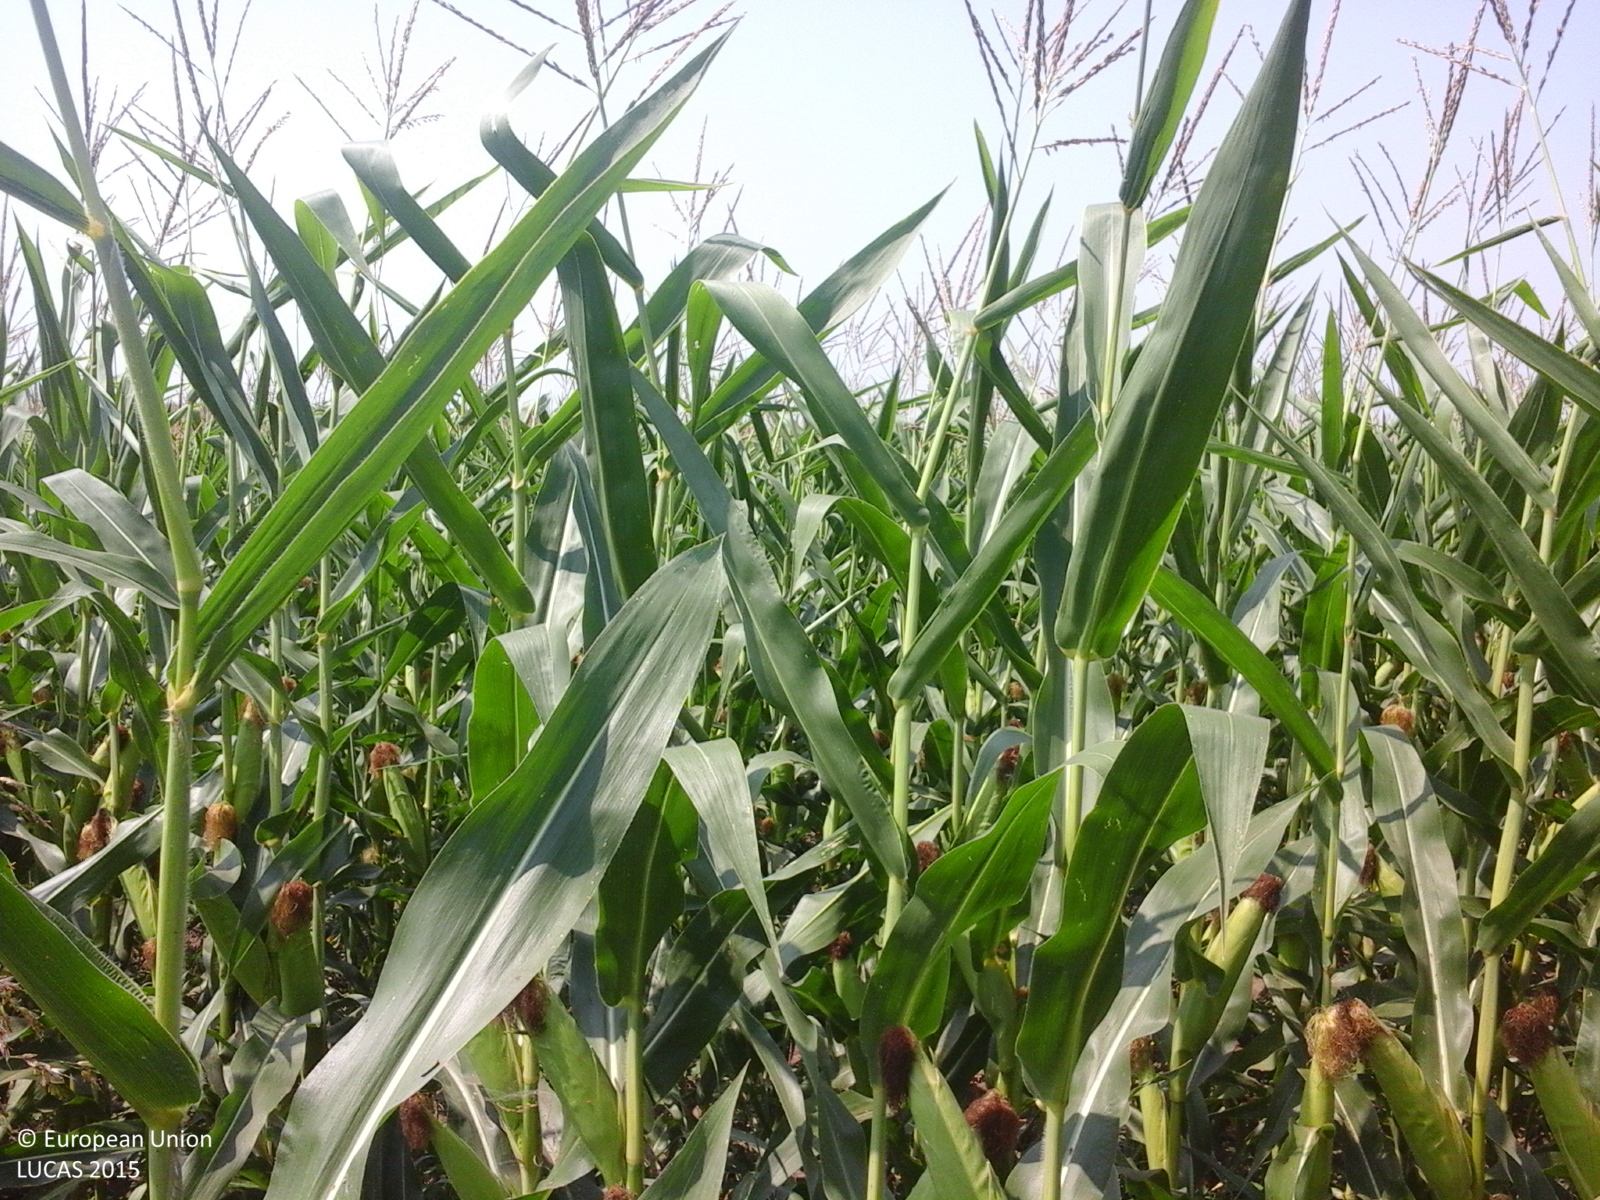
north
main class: Cropland
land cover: Maize
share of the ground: > 75 %
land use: Agriculture (excluding fallow land and kitchen gardens)
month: July
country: RO
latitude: 44.6059
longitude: 26.4576
